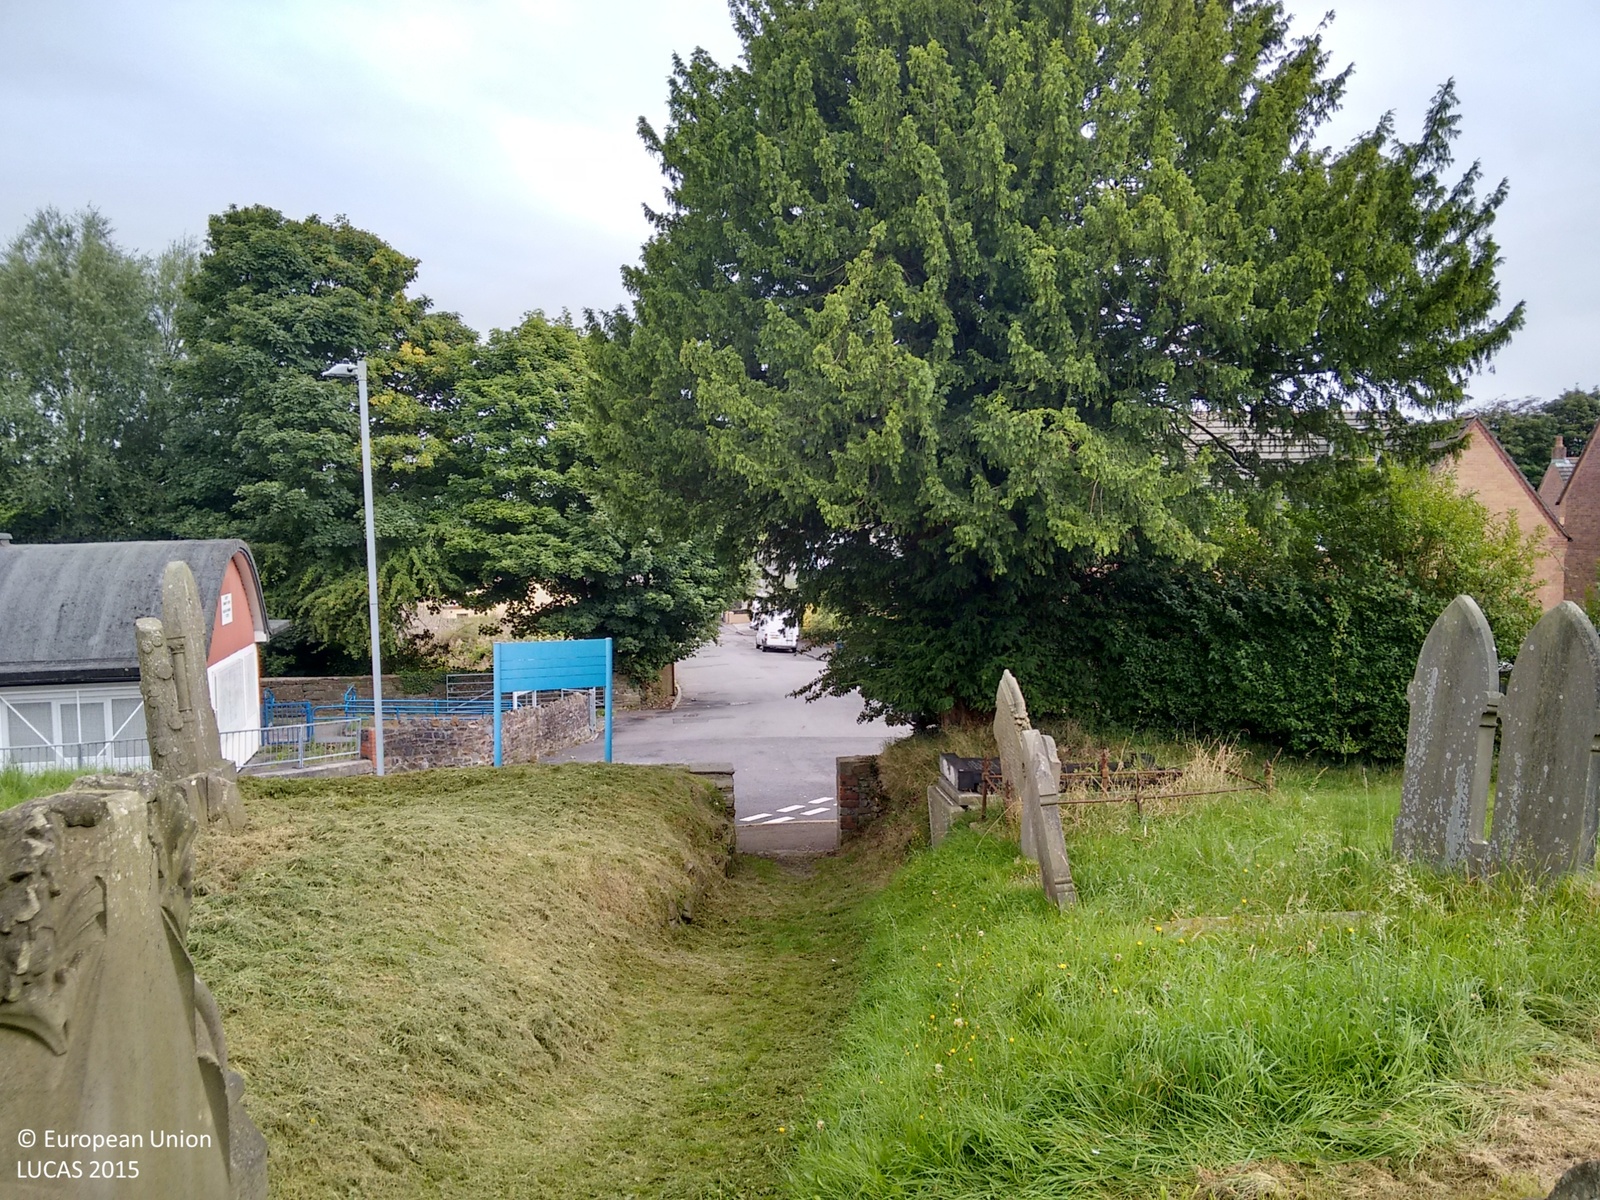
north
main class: Grassland
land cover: Grassland with sparse tree/shrub cover
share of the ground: > 75 %
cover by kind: herbaceous plants 95 %, broadleaved forest trees 5 %
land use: Community services
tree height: > 5 m
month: September
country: GB
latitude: 51.6361
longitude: -3.9793
